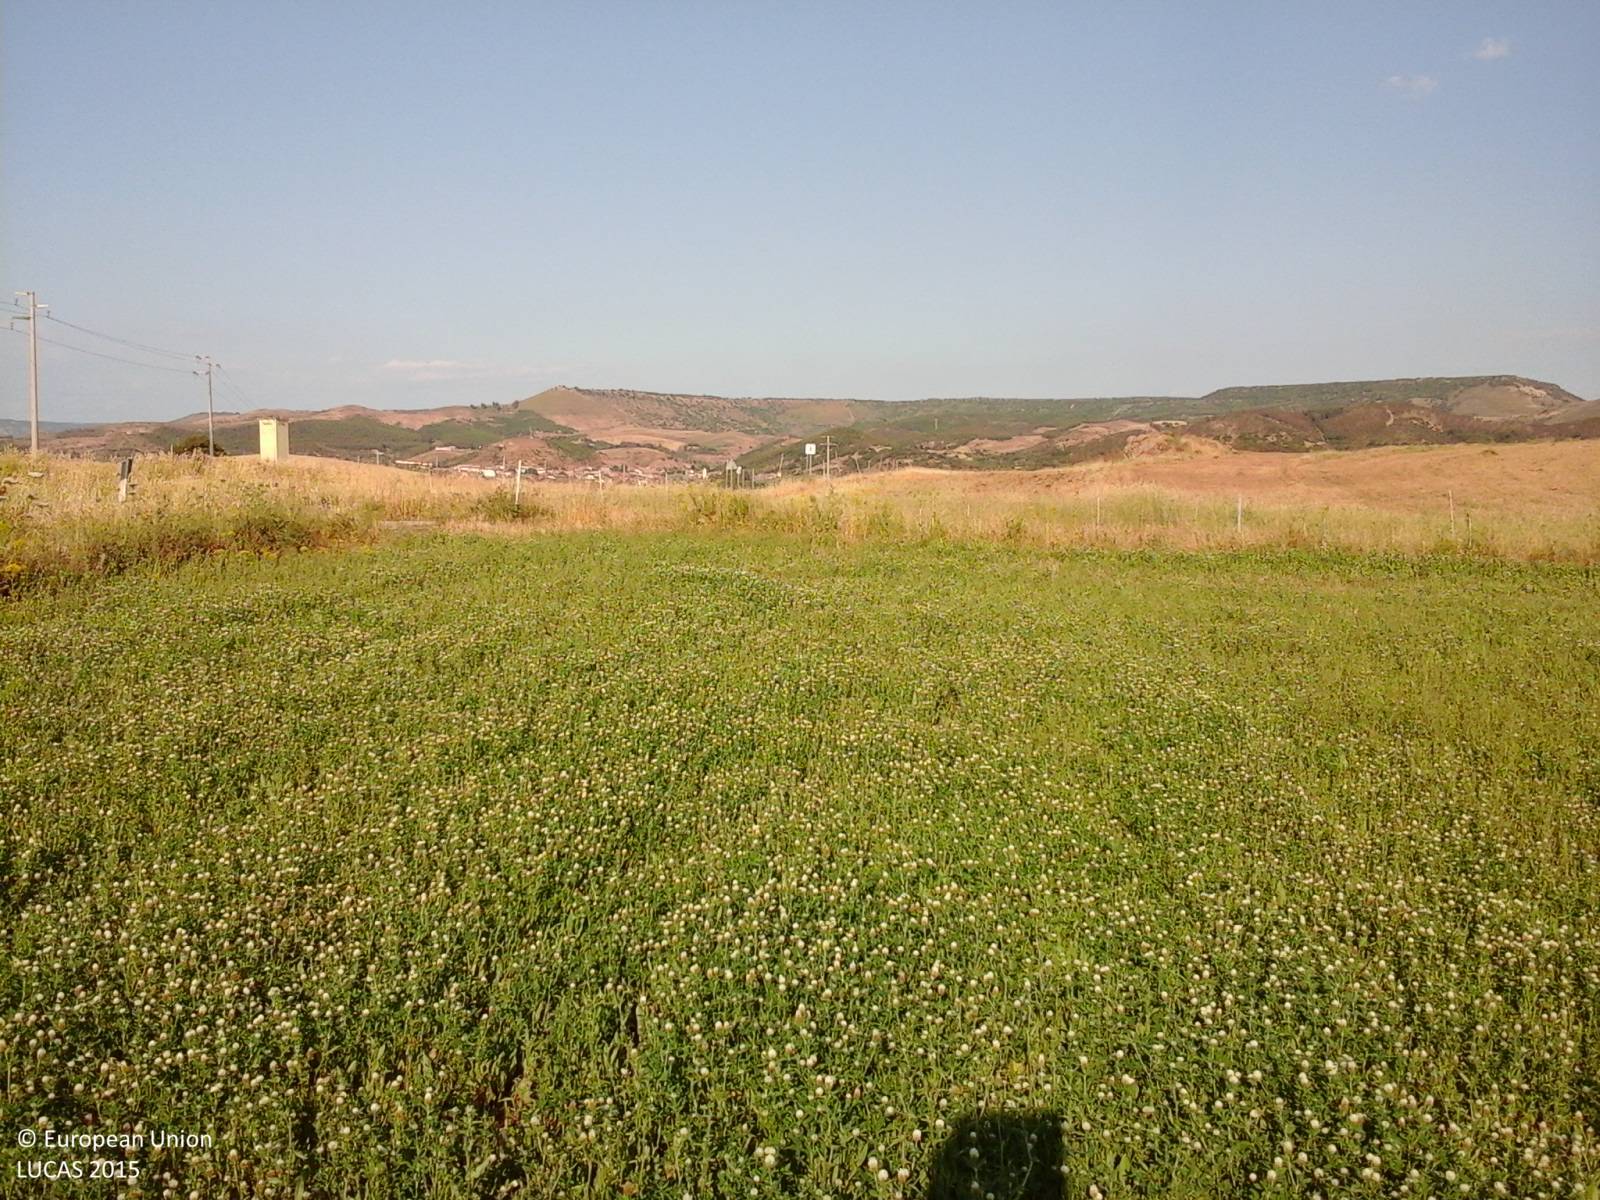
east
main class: Cropland
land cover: Clovers
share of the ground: > 75 %
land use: Agriculture (excluding fallow land and kitchen gardens)
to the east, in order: Clovers; Fences; Grass margins; Paved roads, cycling and walking lanes; Grass margins; Ditches and canals; Fences; Electric lines; Grassland without tree/shrub cover; Tracks; Fences; Common wheat
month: June
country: IT
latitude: 39.6806
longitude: 8.8060
